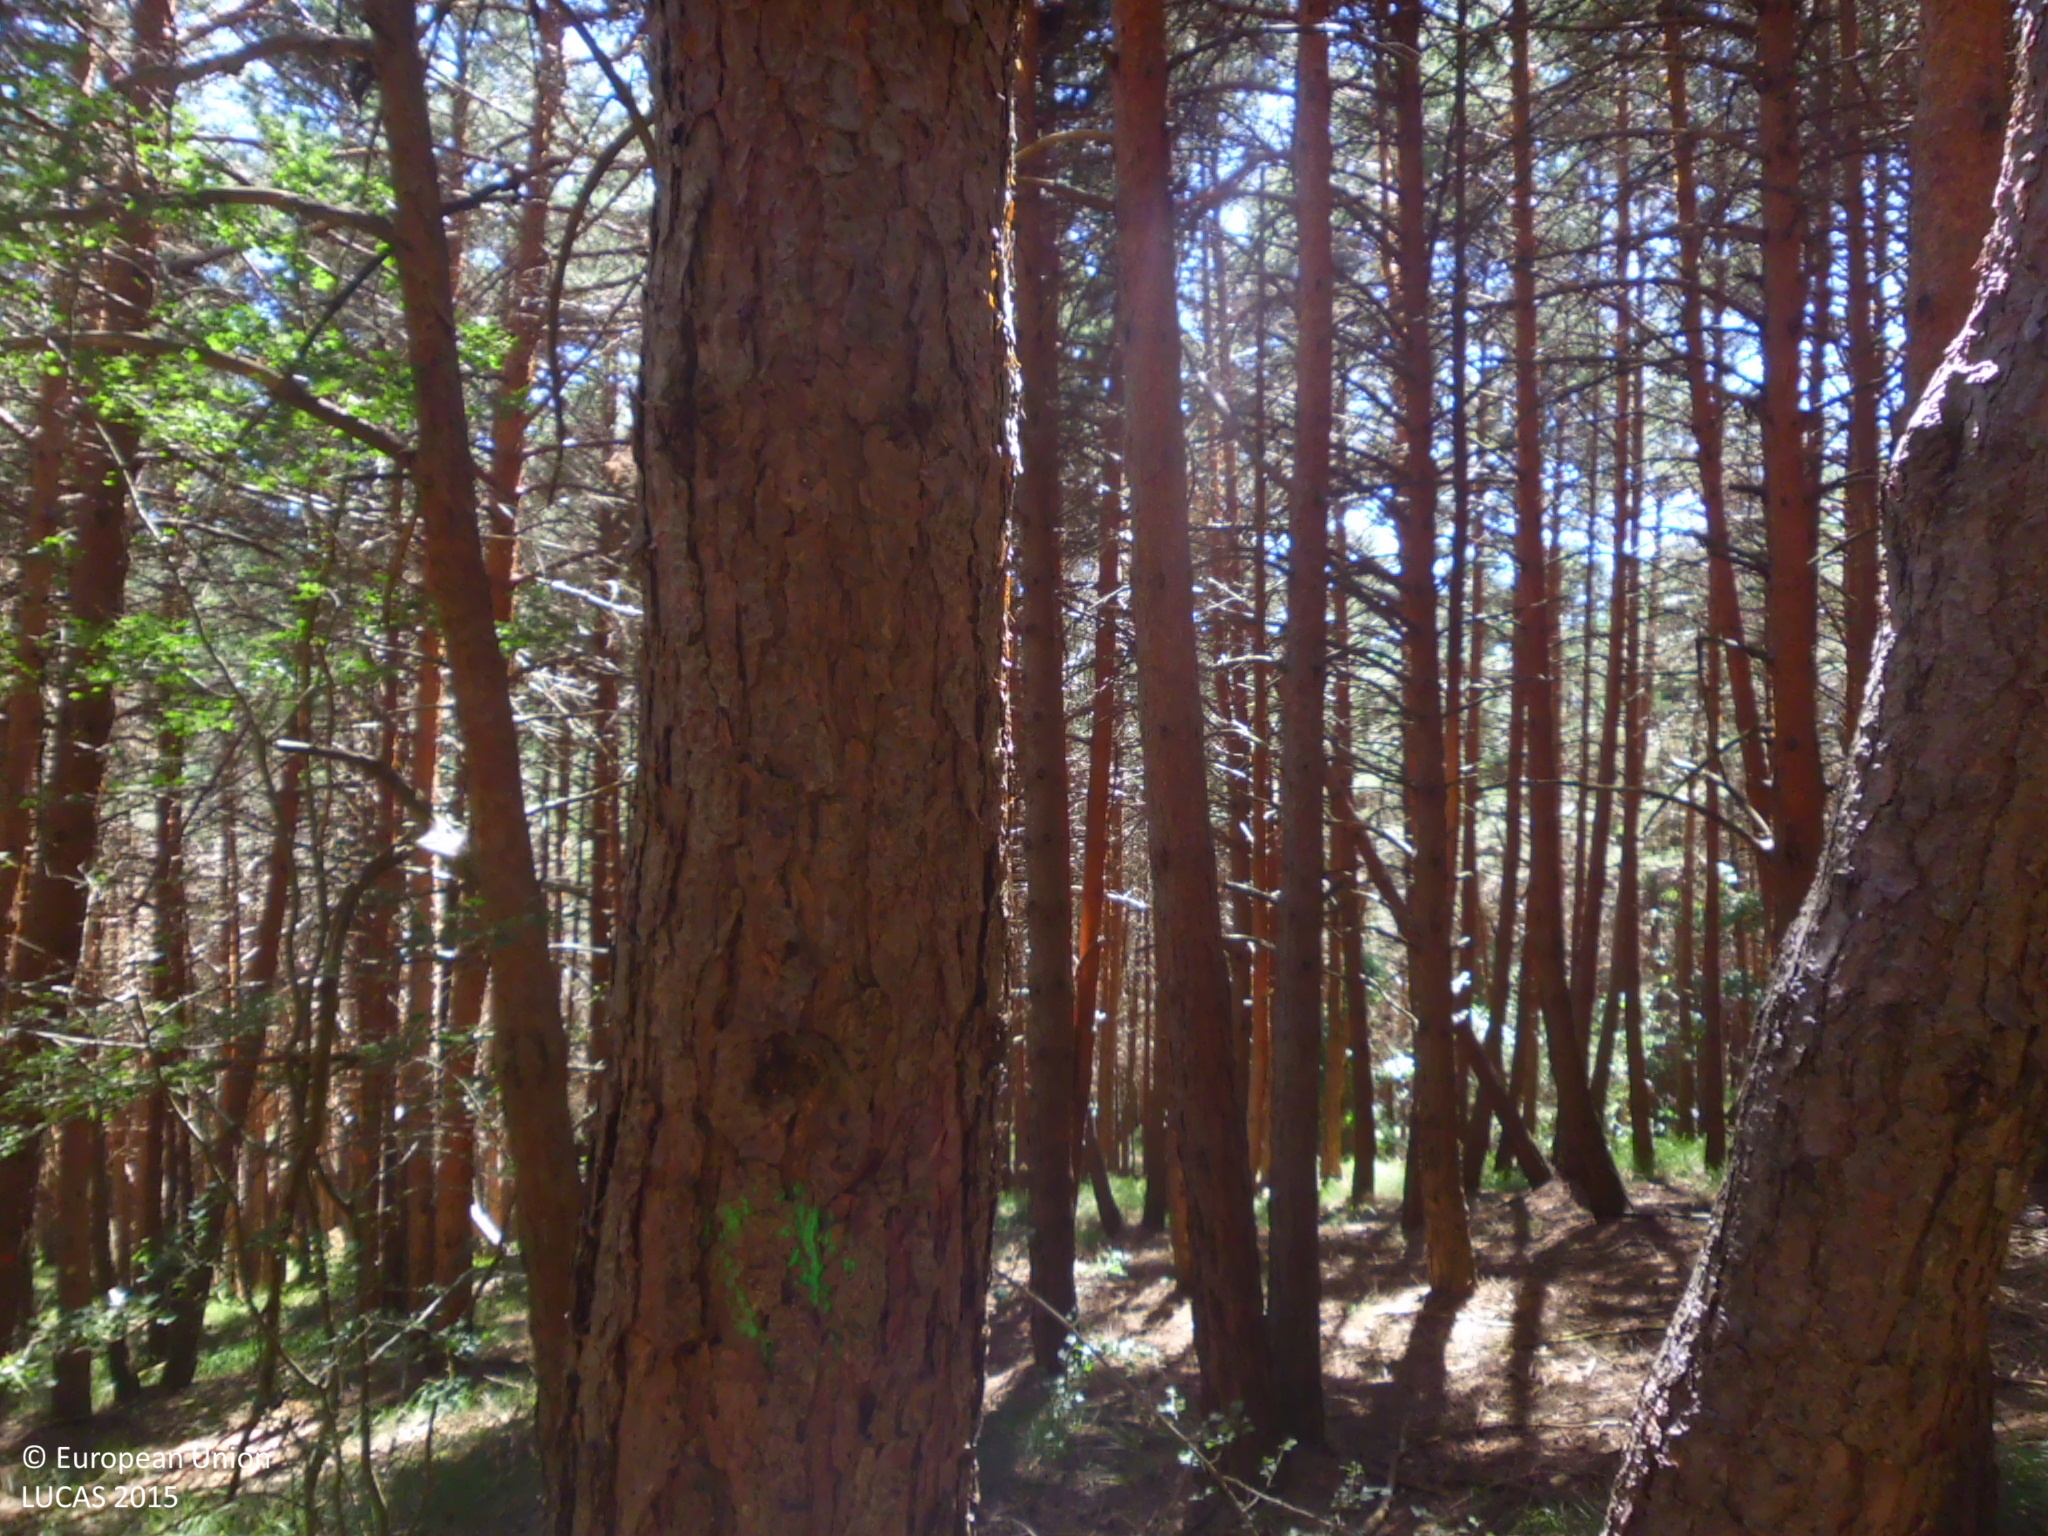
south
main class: Woodland
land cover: Pine dominated coniferous woodland
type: coniferous forest of the mediterranean region
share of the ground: > 75 %
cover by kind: coniferous forest trees 100 %
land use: Forestry
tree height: > 5 m
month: July
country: ES
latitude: 42.8328
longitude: -4.1043
